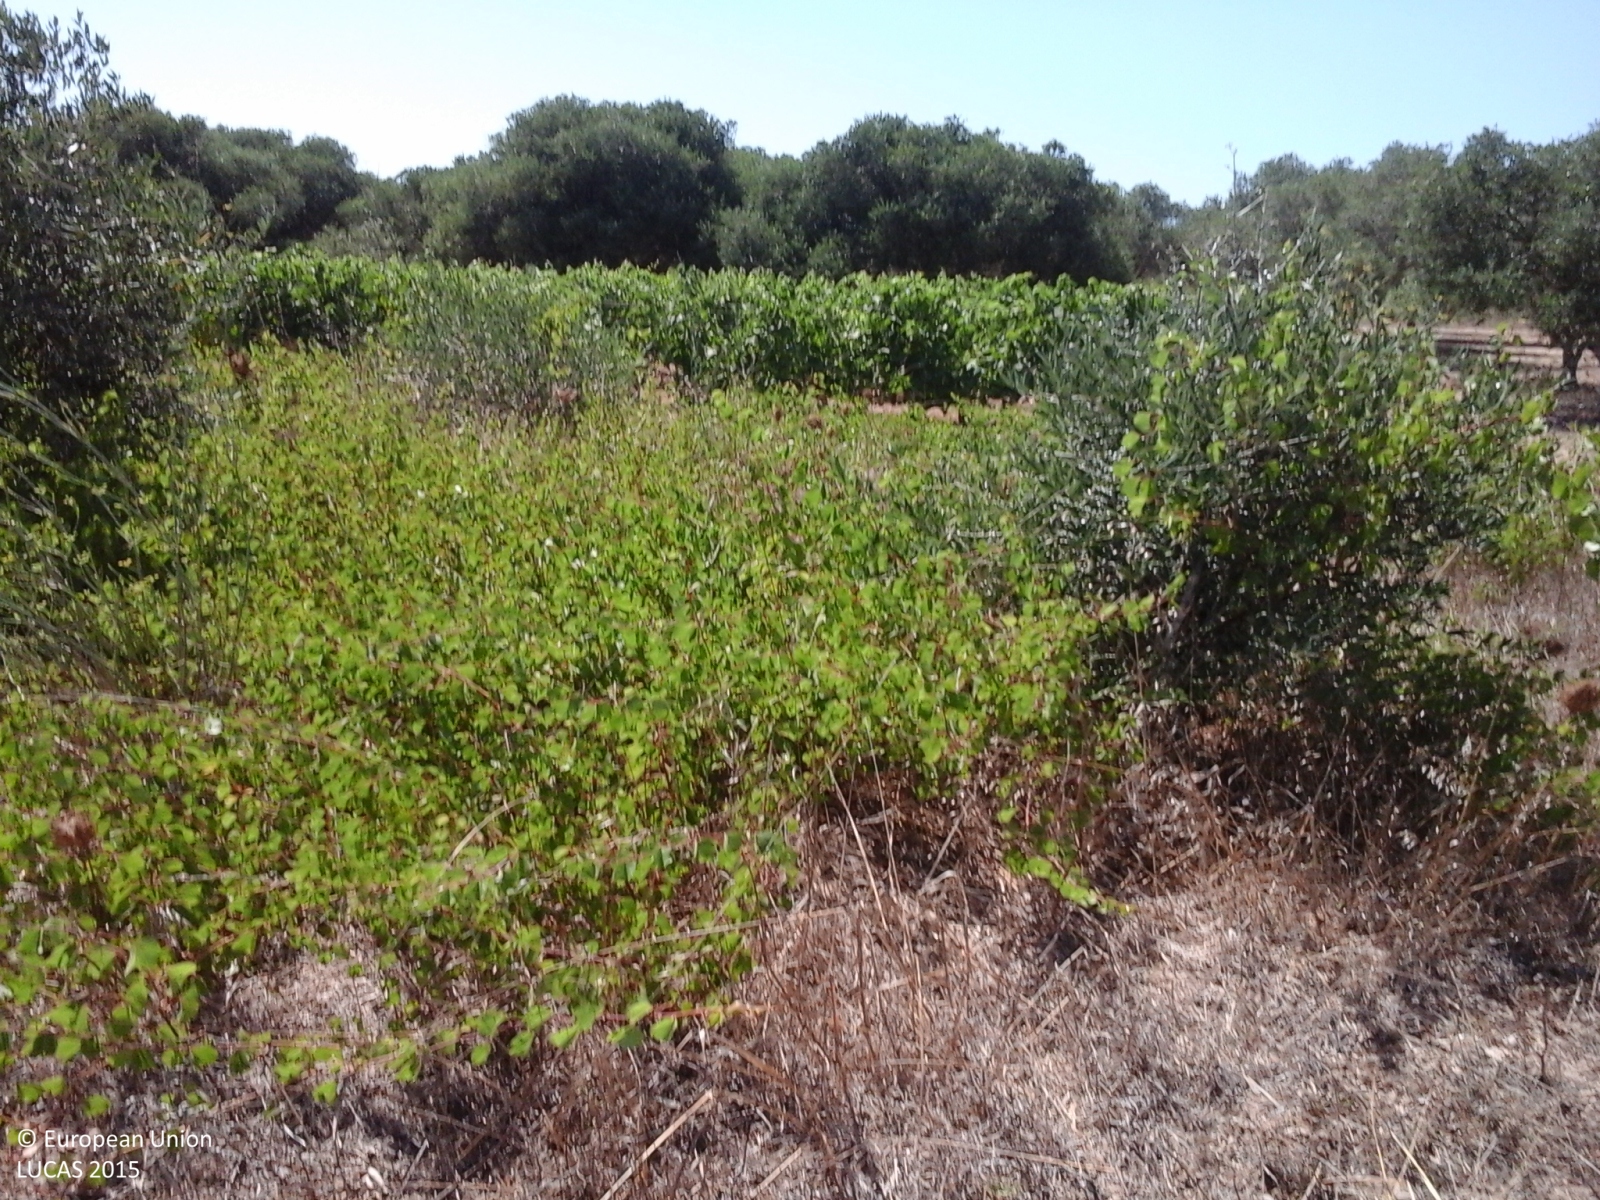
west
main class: Cropland
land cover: Durum wheat
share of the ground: > 75 %
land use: Agriculture (excluding fallow land and kitchen gardens)
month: July
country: IT
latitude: 39.9292
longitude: 8.4523
